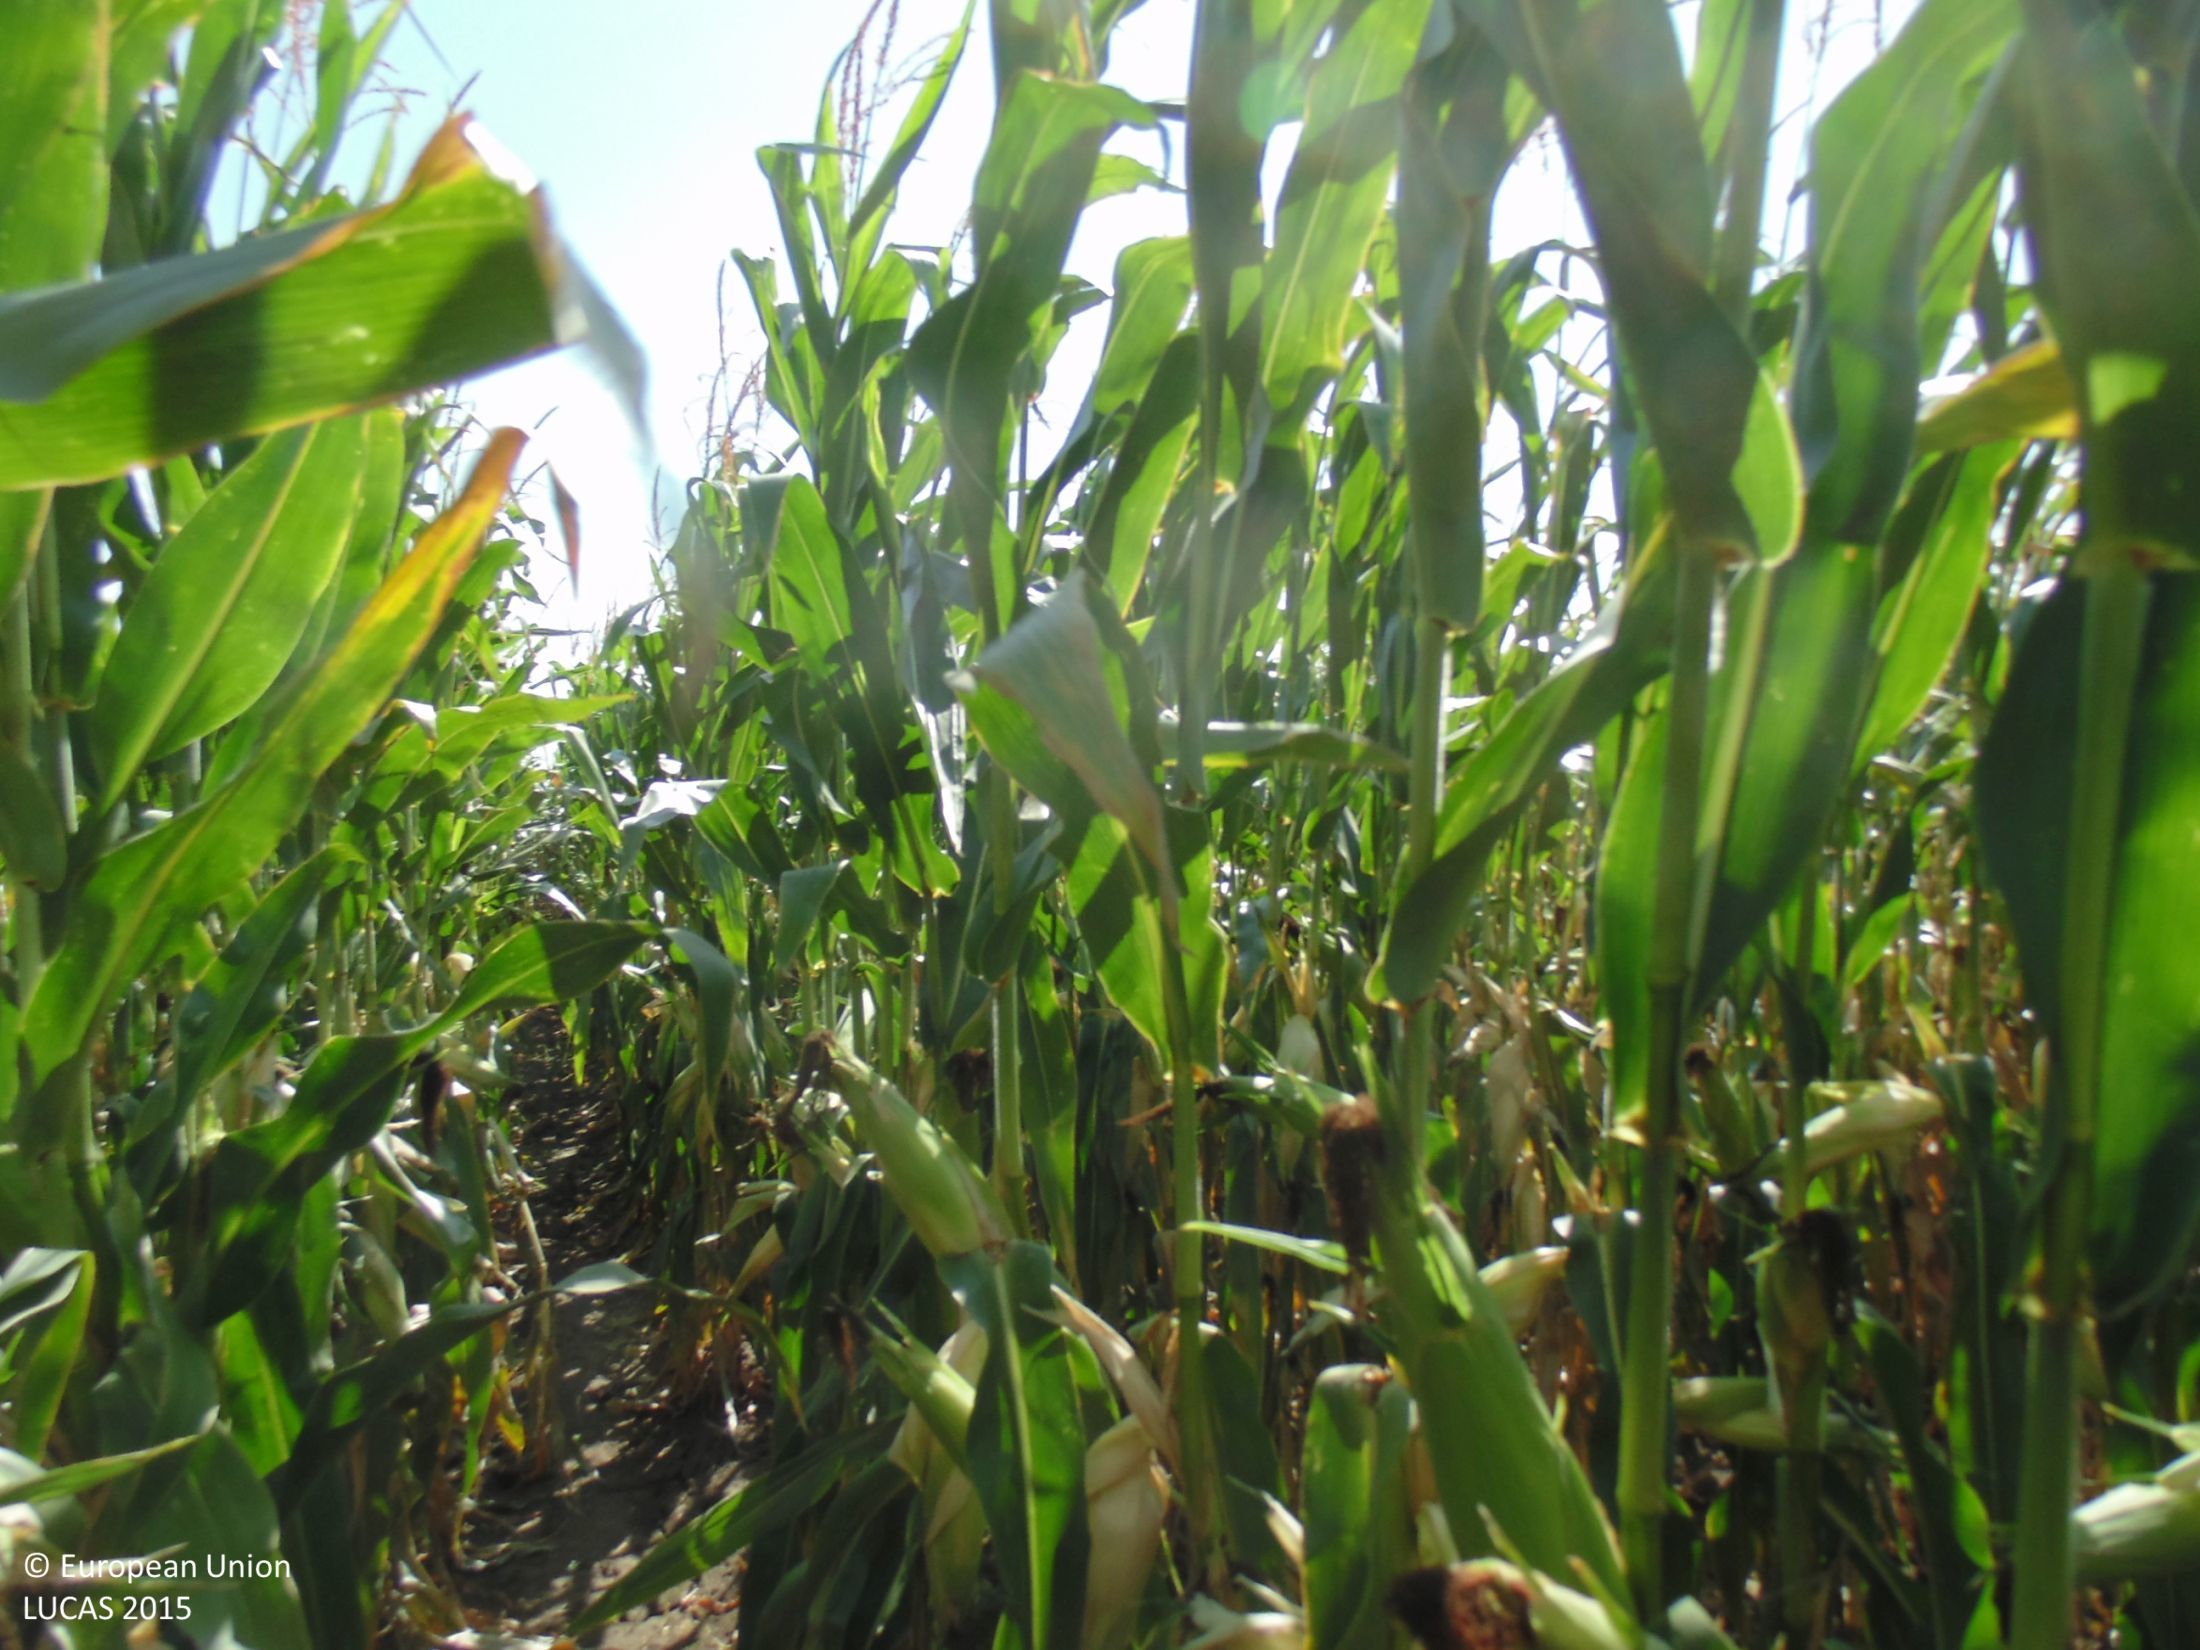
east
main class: Cropland
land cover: Maize
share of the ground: > 75 %
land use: Agriculture (excluding fallow land and kitchen gardens)
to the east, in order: Maize; Grass margins; Tracks; Grass margins; Maize
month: August
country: BG
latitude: 43.6615
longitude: 28.2221
